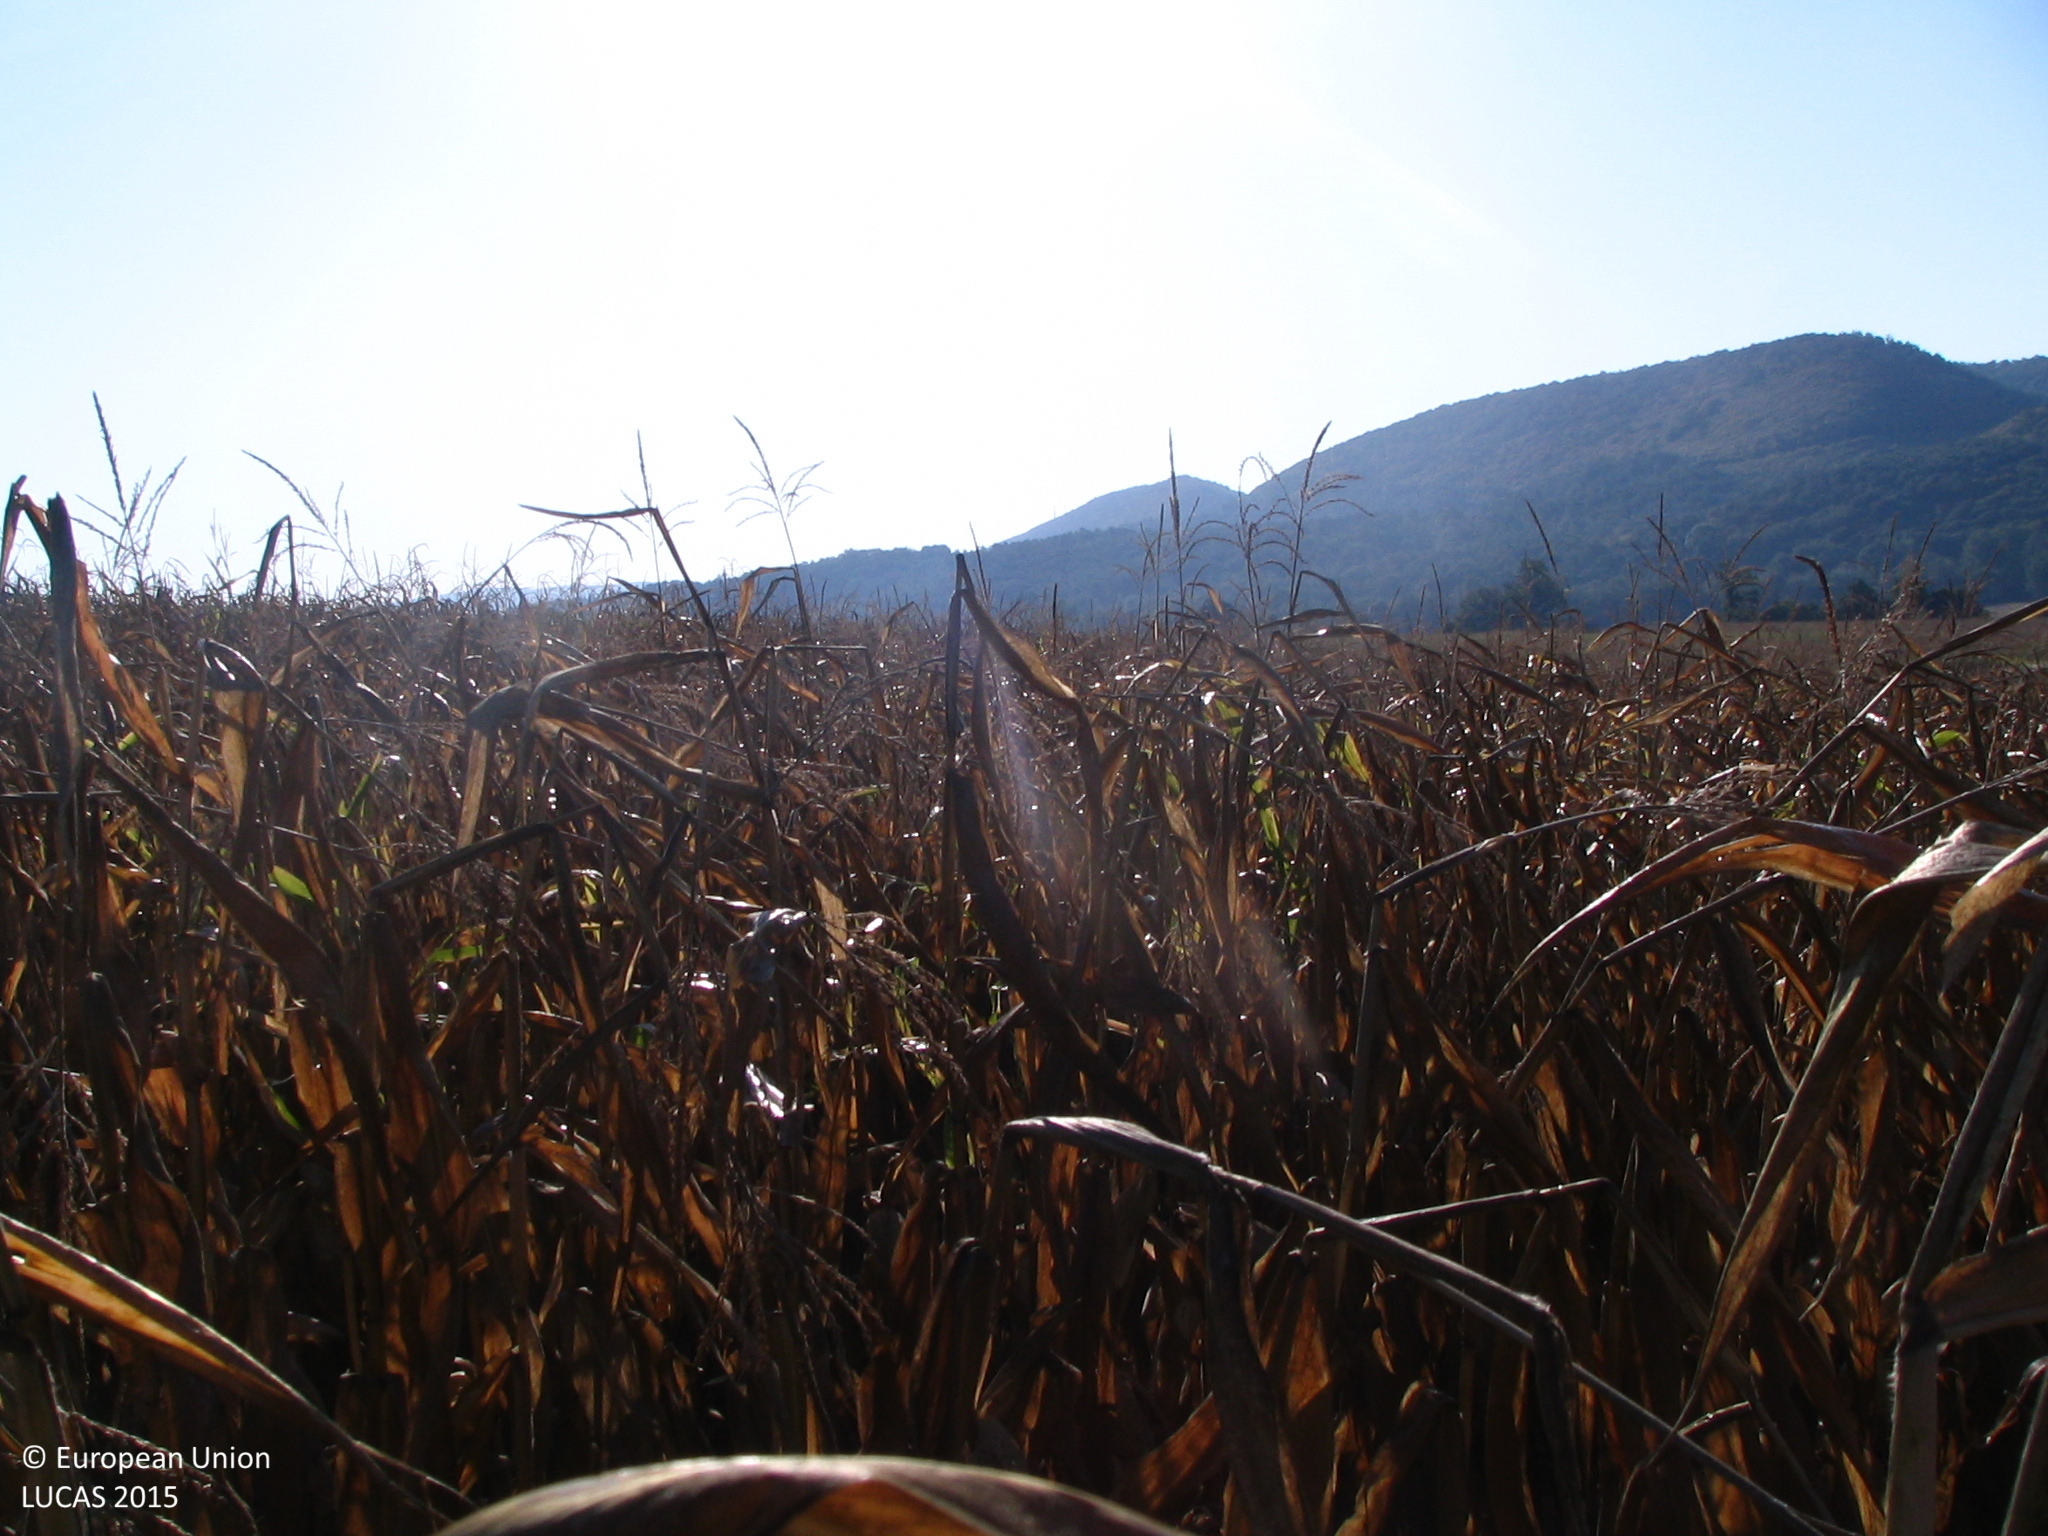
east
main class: Cropland
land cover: Maize
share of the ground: > 75 %
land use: Agriculture (excluding fallow land and kitchen gardens)
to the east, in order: Maize
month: August
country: BG
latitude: 43.0606
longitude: 24.4344
